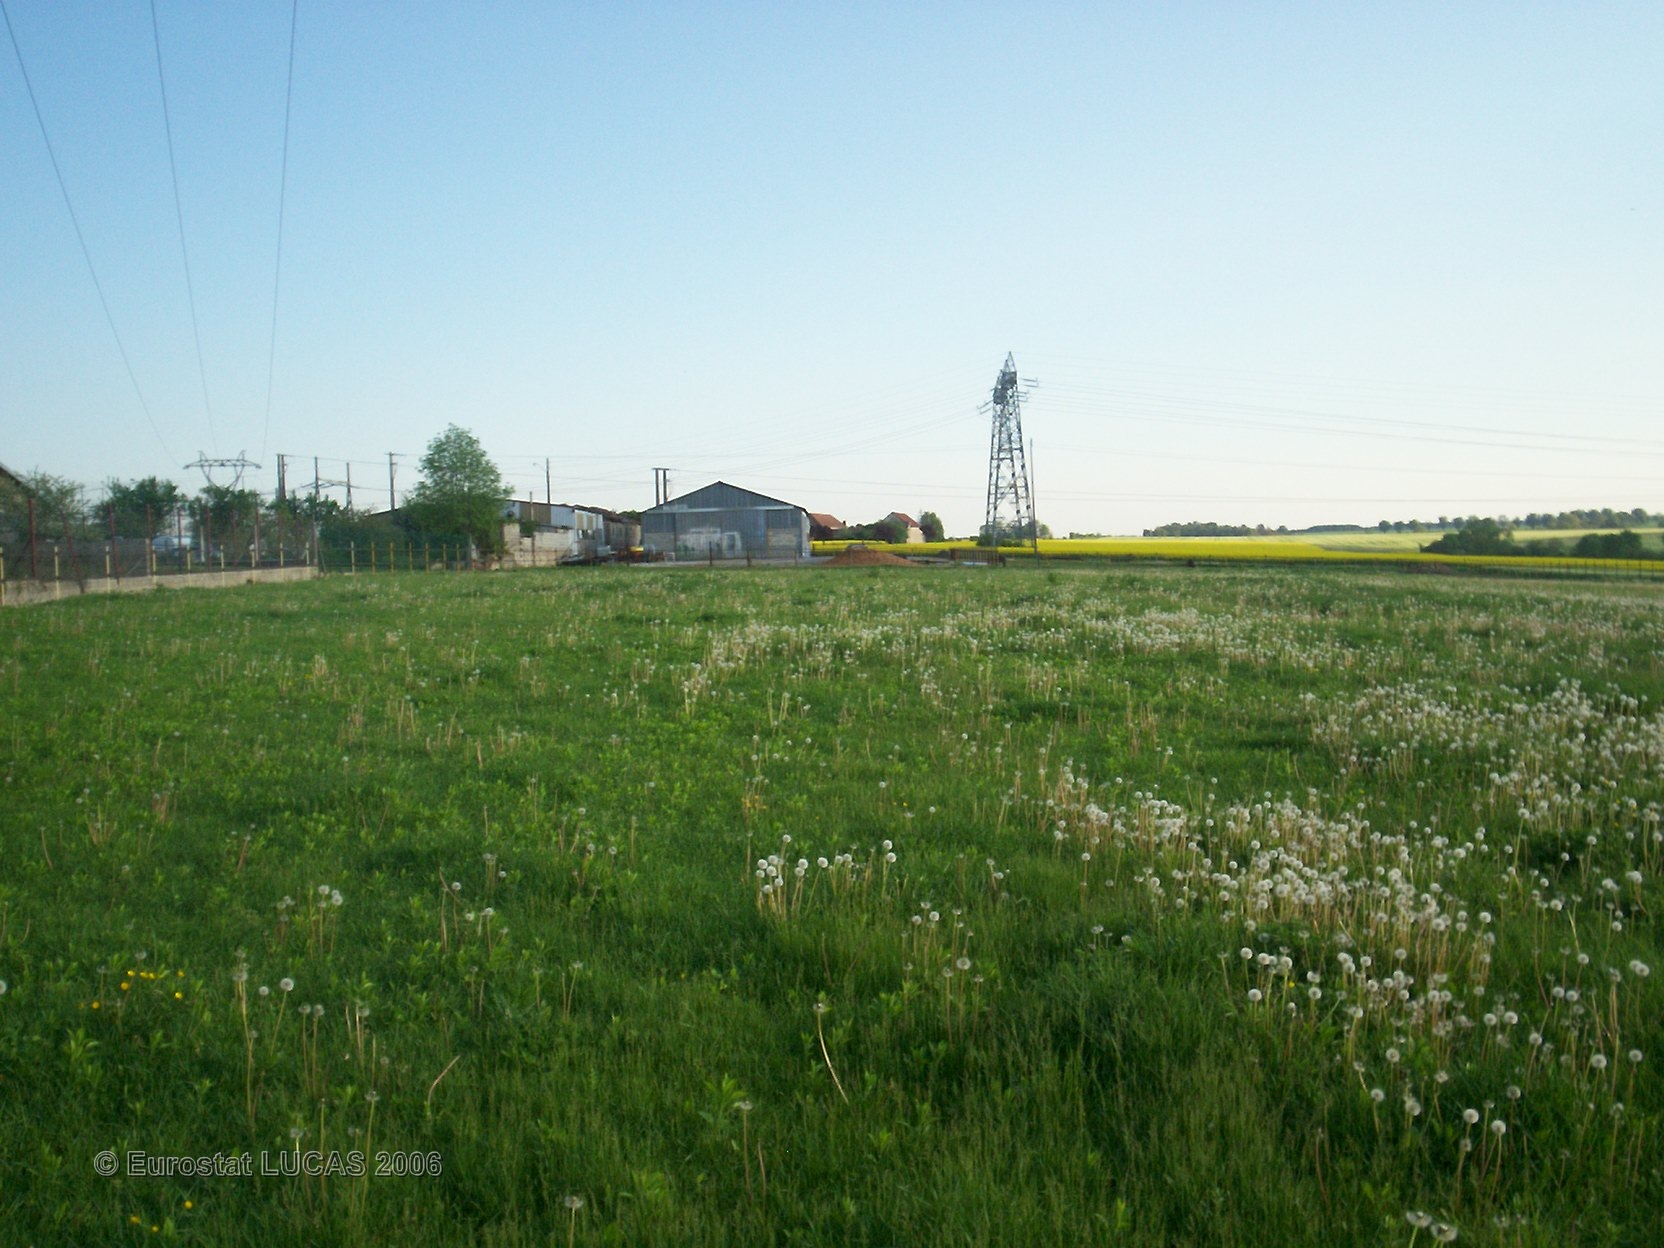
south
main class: Grassland
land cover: Grassland without tree/shrub cover
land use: Agriculture (excluding fallow land and kitchen gardens)
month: May
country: FR
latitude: 47.8547
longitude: 4.5588
